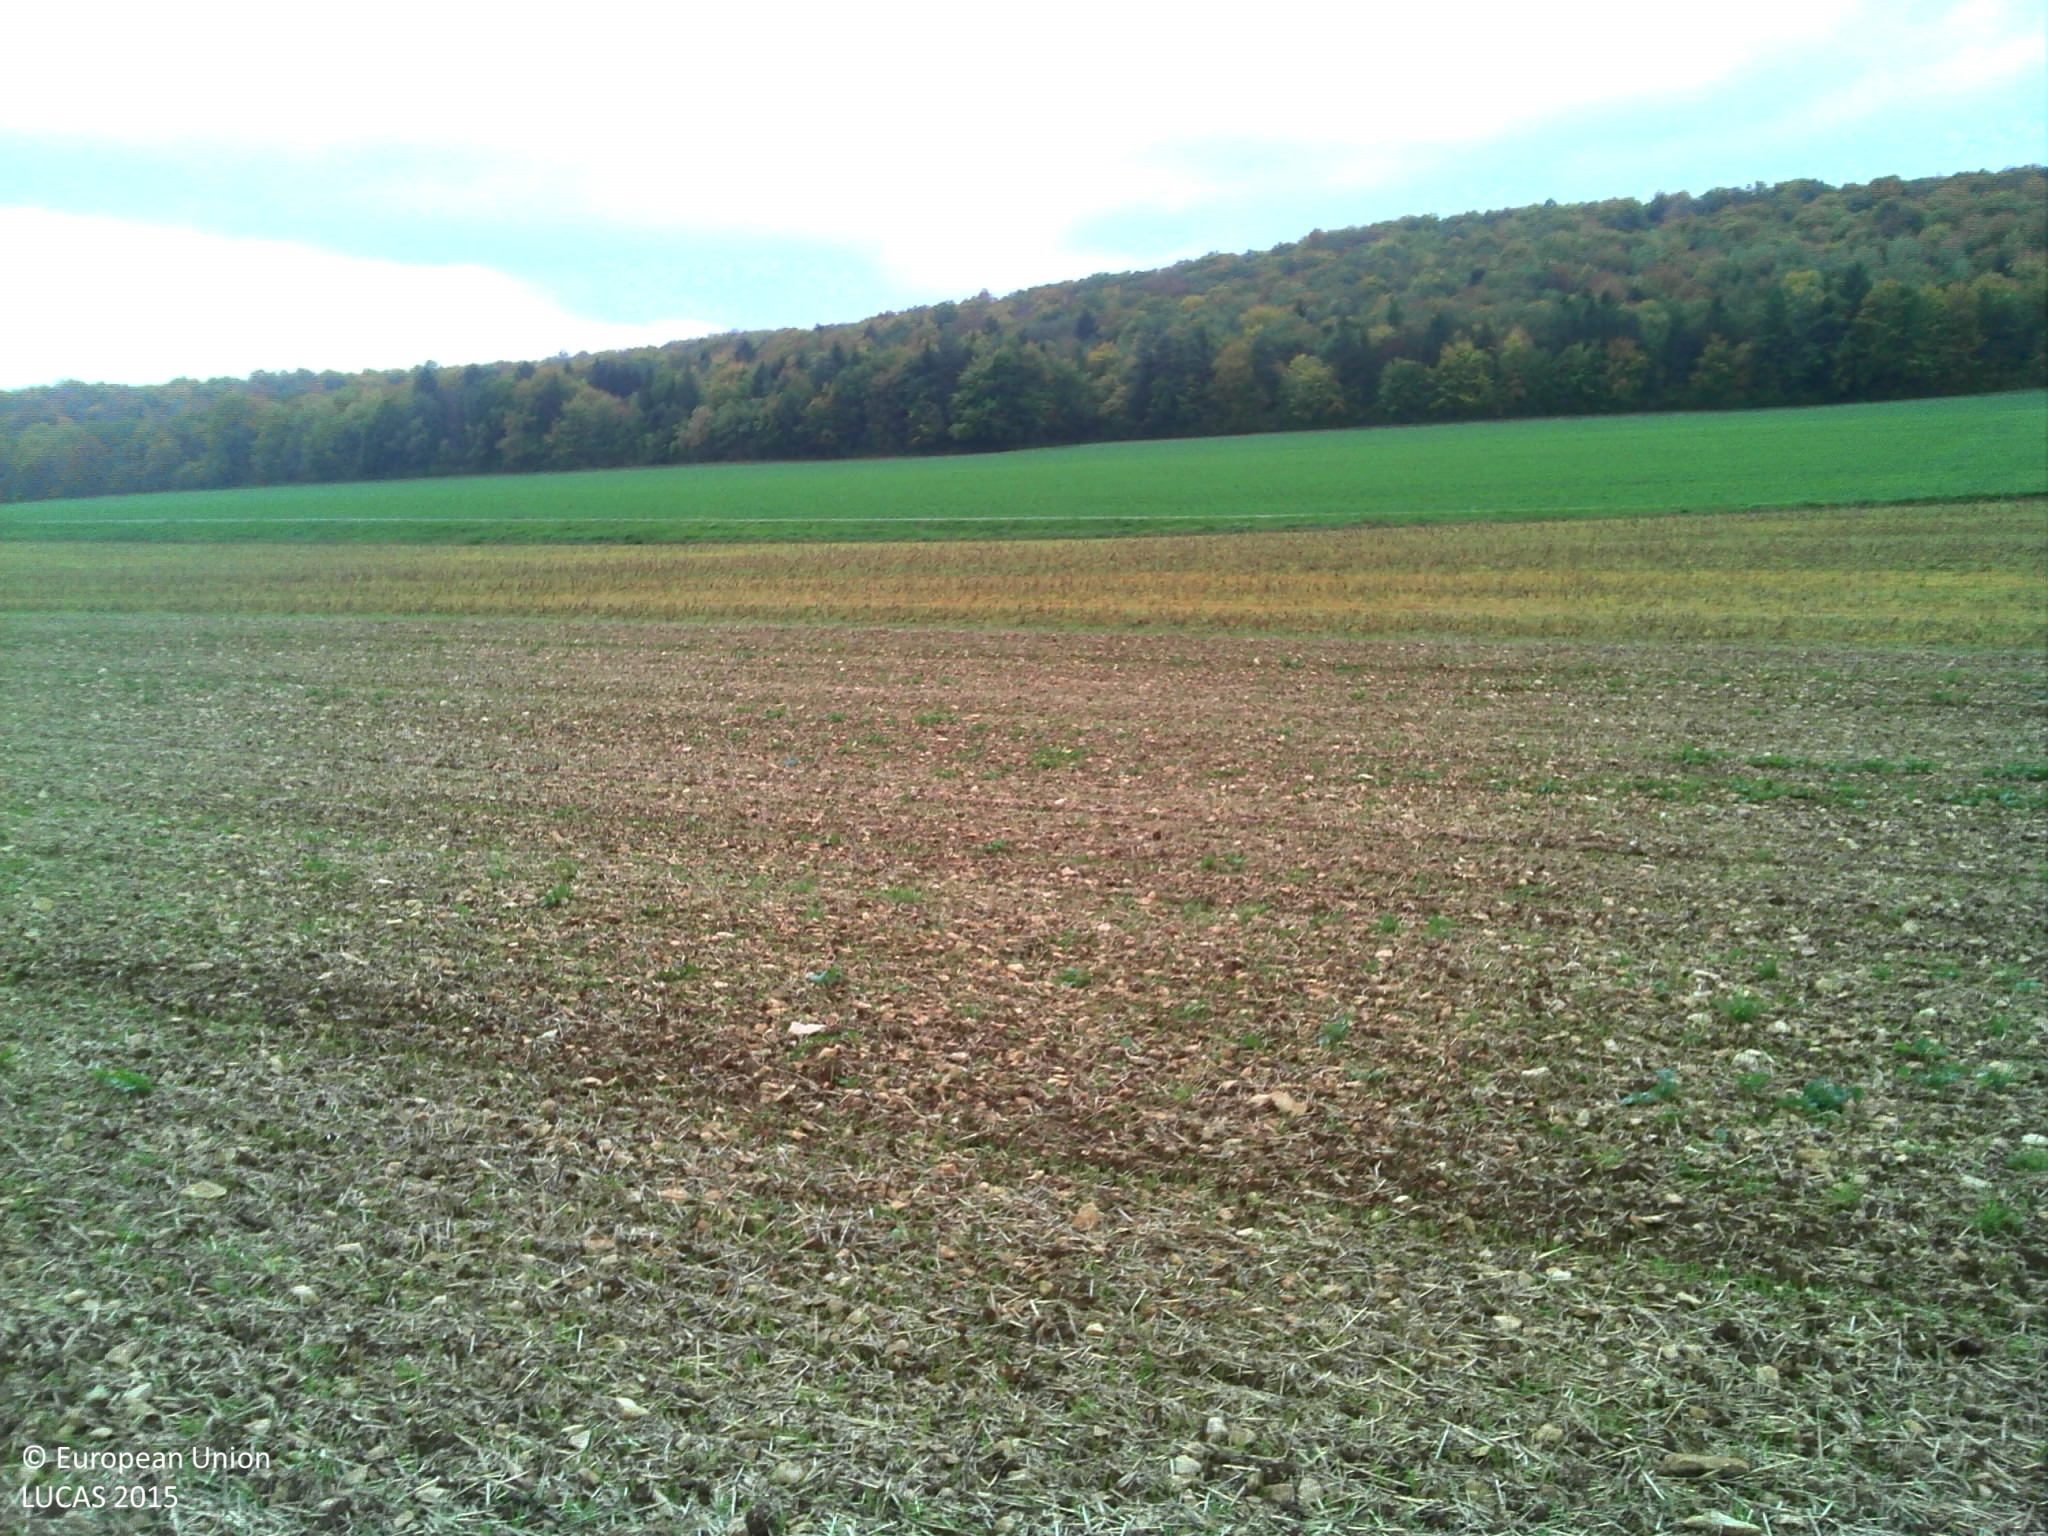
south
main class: Cropland
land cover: Common wheat
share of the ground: 10 - 25 %
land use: Agriculture (excluding fallow land and kitchen gardens)
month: October
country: FR
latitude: 47.5352
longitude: 5.0451
